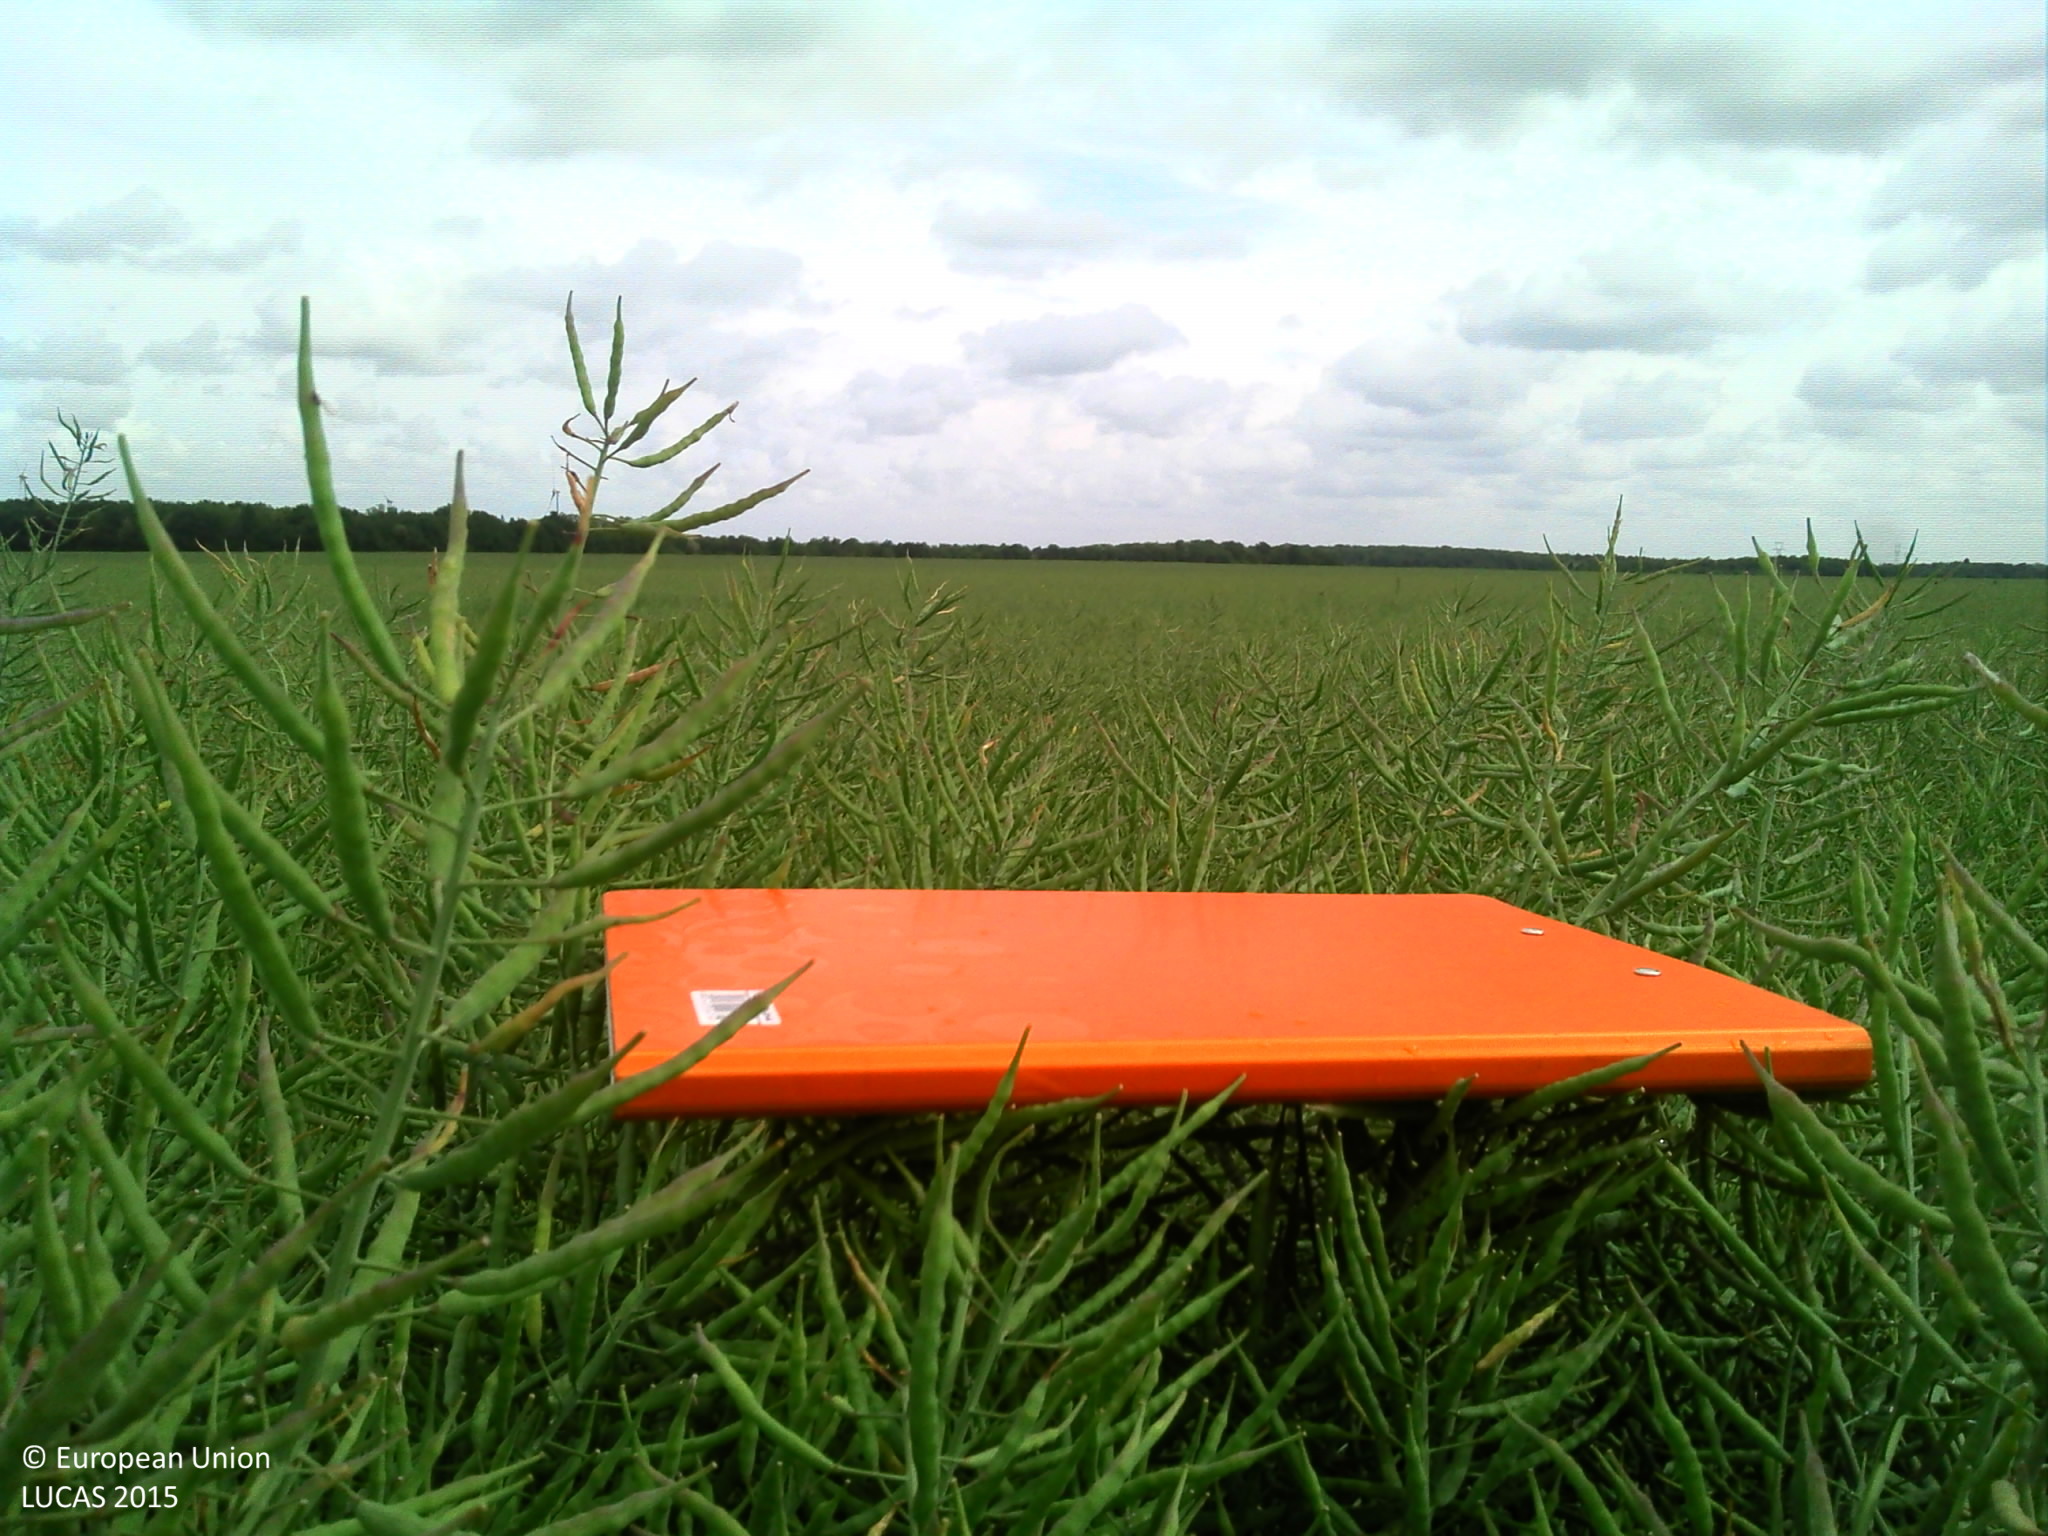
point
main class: Cropland
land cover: Rape and turnip rape
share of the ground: > 75 %
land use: Agriculture (excluding fallow land and kitchen gardens)
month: June
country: FR
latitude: 48.3453
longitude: 1.9584
